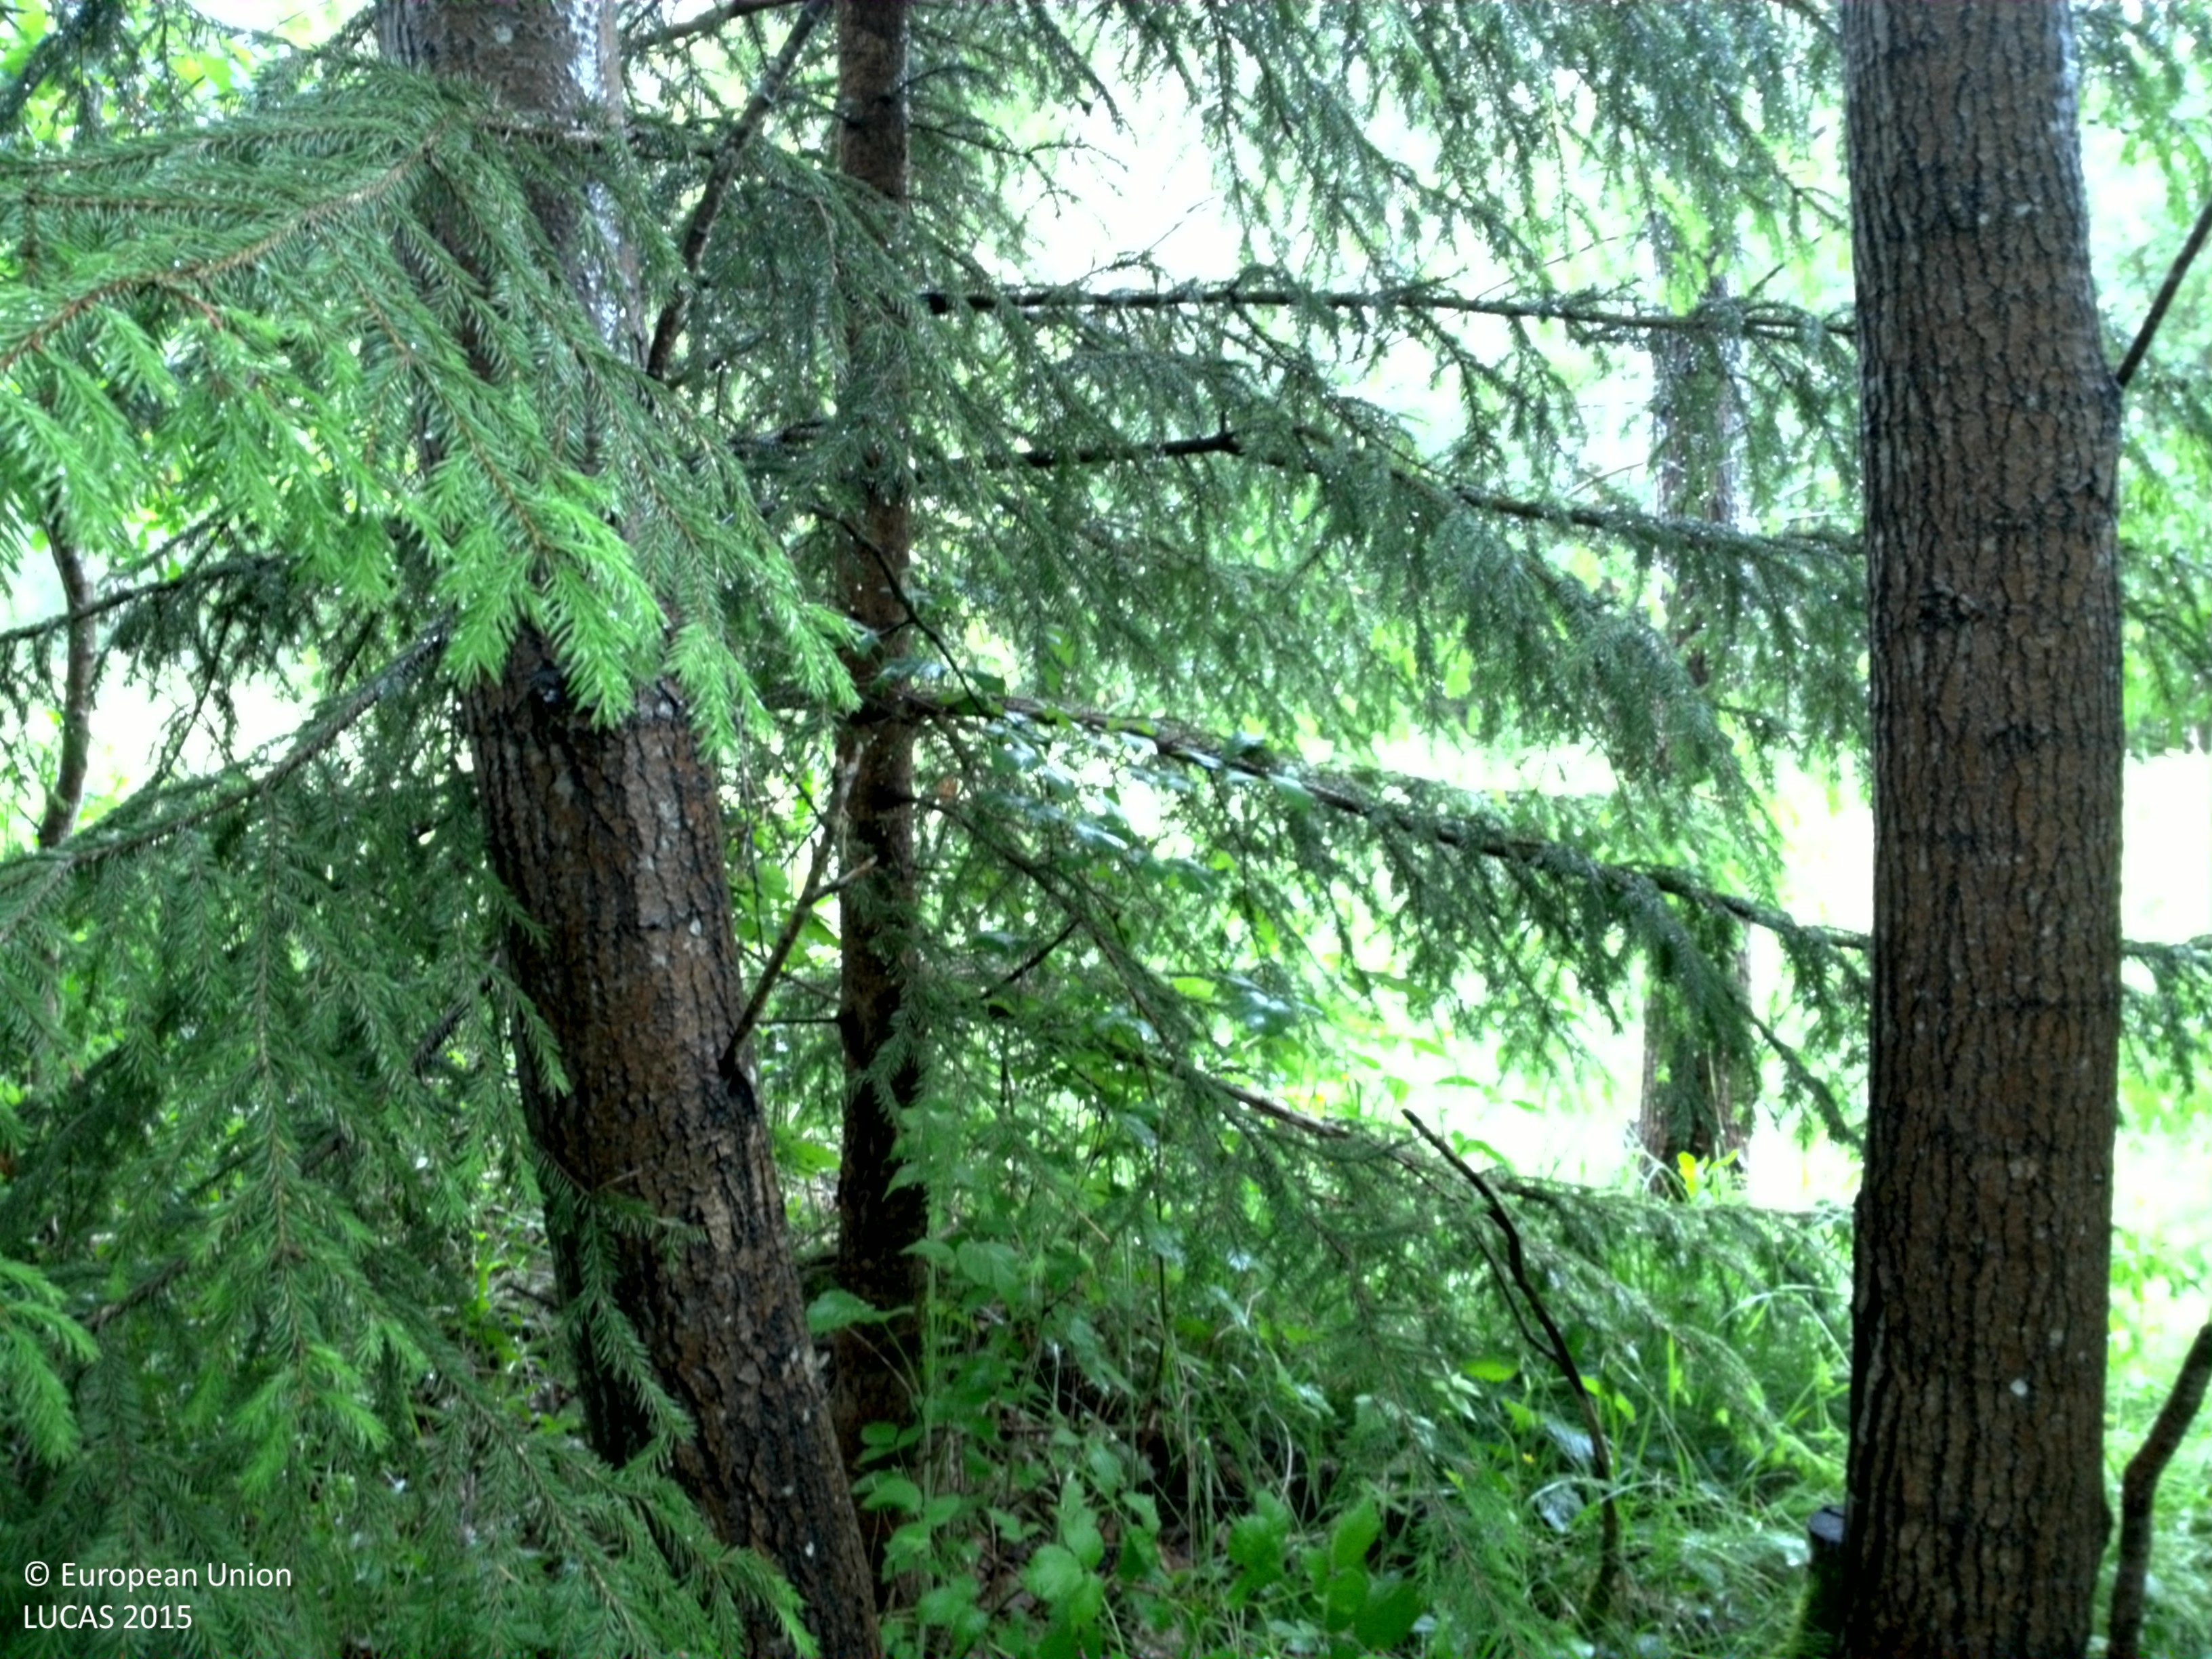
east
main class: Woodland
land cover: Broadleaved woodland
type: acidophilous oak and oak-birch forest
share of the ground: > 75 %
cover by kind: broadleaved forest trees 85 %, herbaceous plants 15 %
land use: Forestry
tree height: > 5 m
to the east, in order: Broadleaved woodland; Grassland without tree/shrub cover; Broadleaved woodland; Ditches and canals; Broadleaved woodland; Grassland without tree/shrub cover; Broadleaved woodland; Grassland without tree/shrub cover; Temporary grasslands; Grassland without tree/shrub cover; Broadleaved woodland
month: June
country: SE
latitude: 58.7243
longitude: 15.3987
